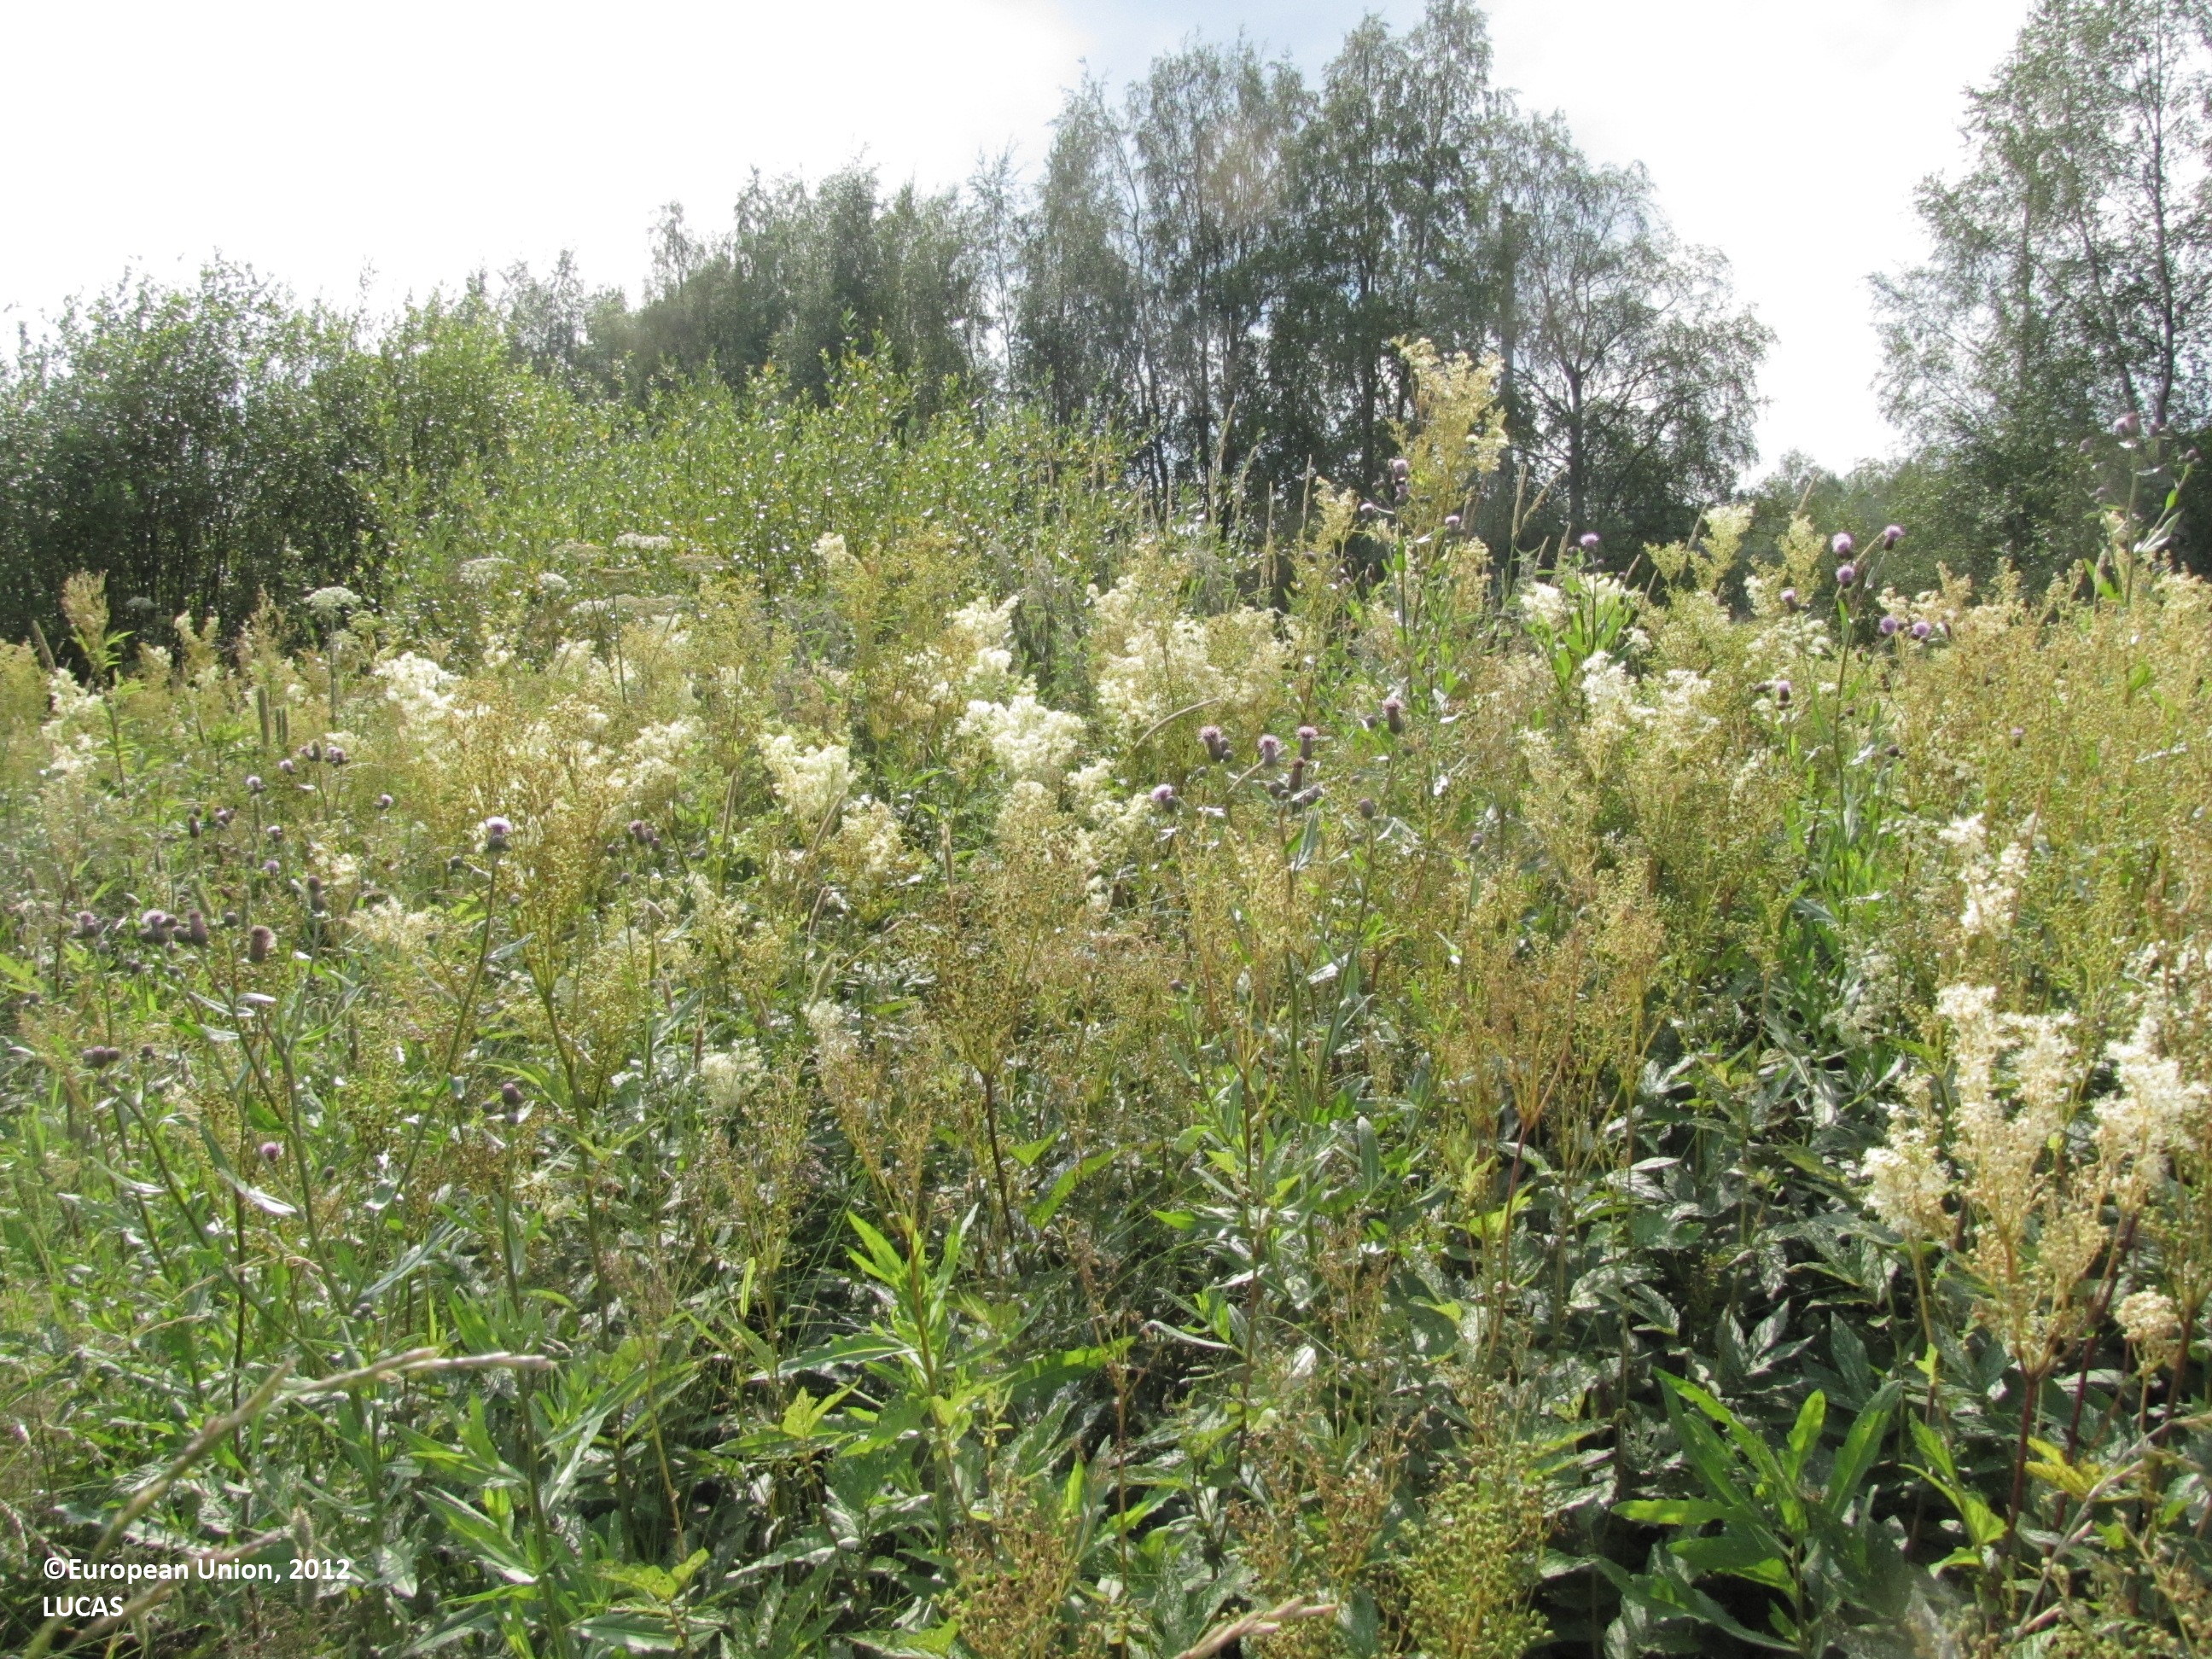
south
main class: Cropland
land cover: Temporary grasslands
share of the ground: > 75 %
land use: Agriculture (excluding fallow land and kitchen gardens)
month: July
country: FI
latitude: 62.0061
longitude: 23.0349
